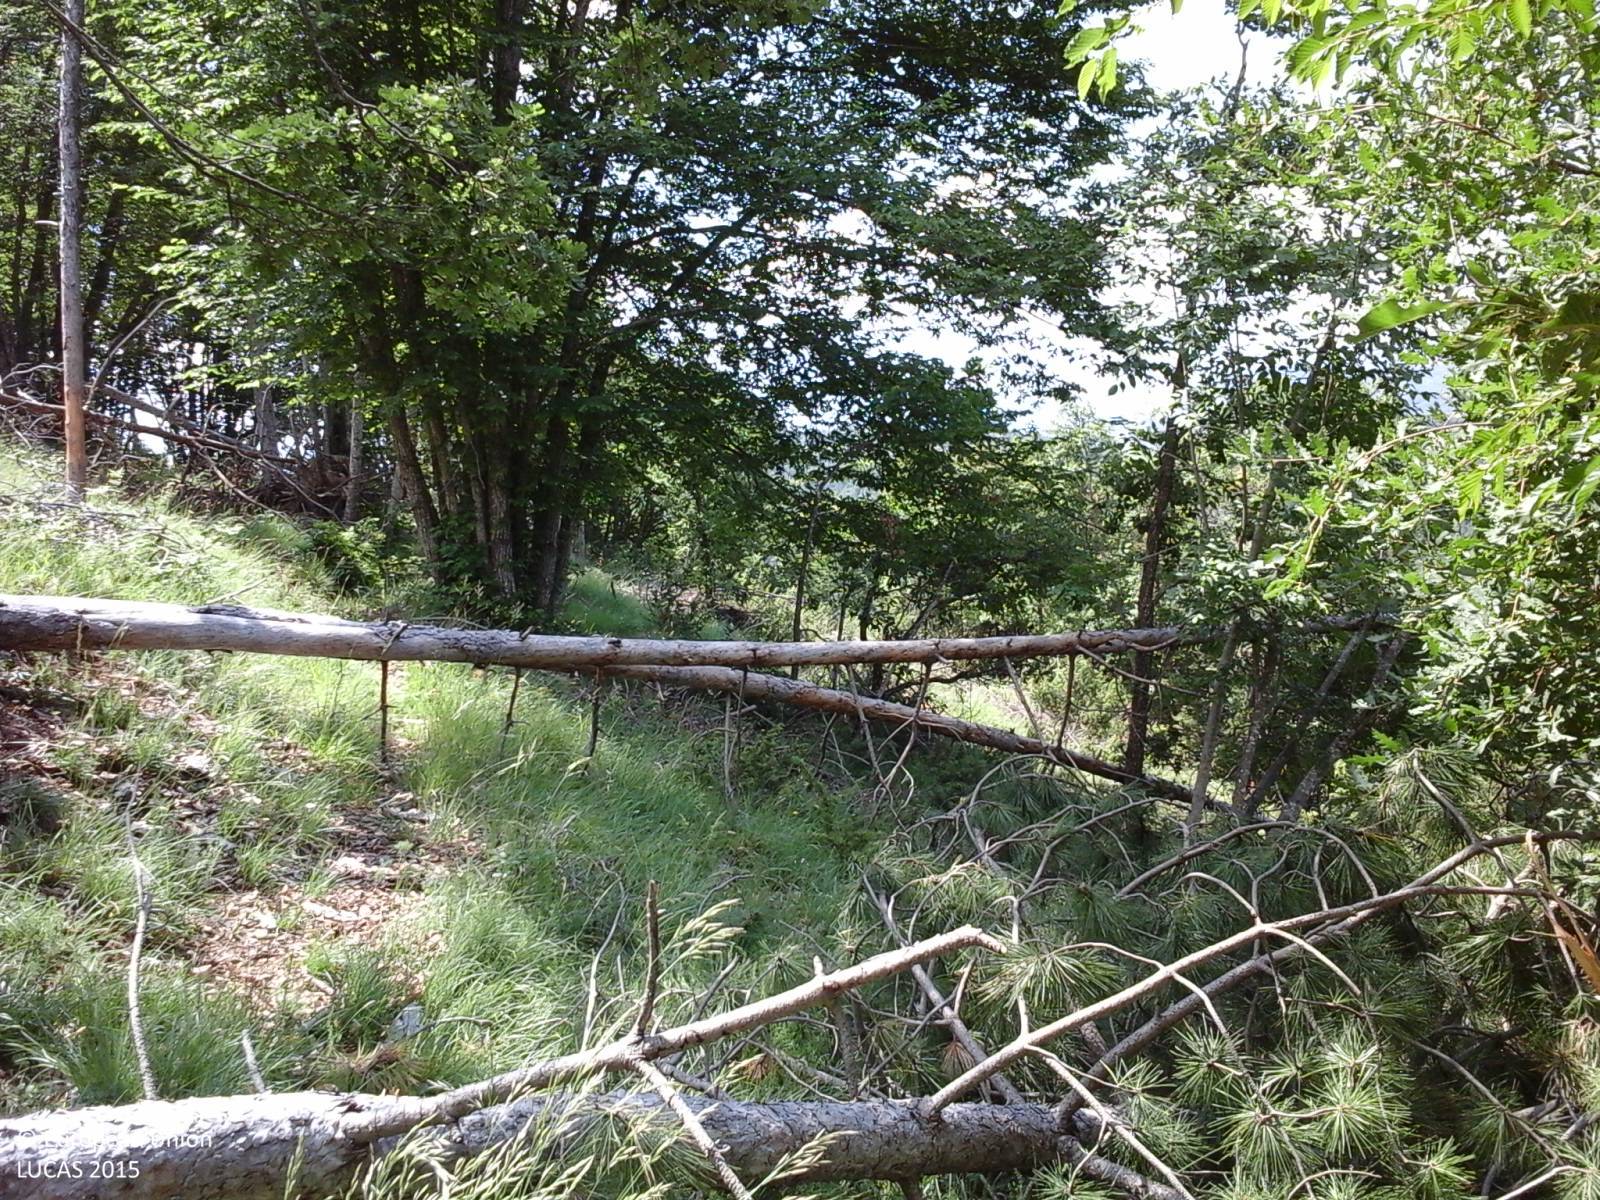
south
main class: Woodland
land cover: Broadleaved woodland
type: thermophilous deciduous forest
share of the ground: > 75 %
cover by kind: broadleaved forest trees 45 %, herbaceous plants 35 %, shrubs 15 %, coniferous forest trees 5 %
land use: Forestry
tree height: < 5 m
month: June
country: IT
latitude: 42.1478
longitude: 13.3165
